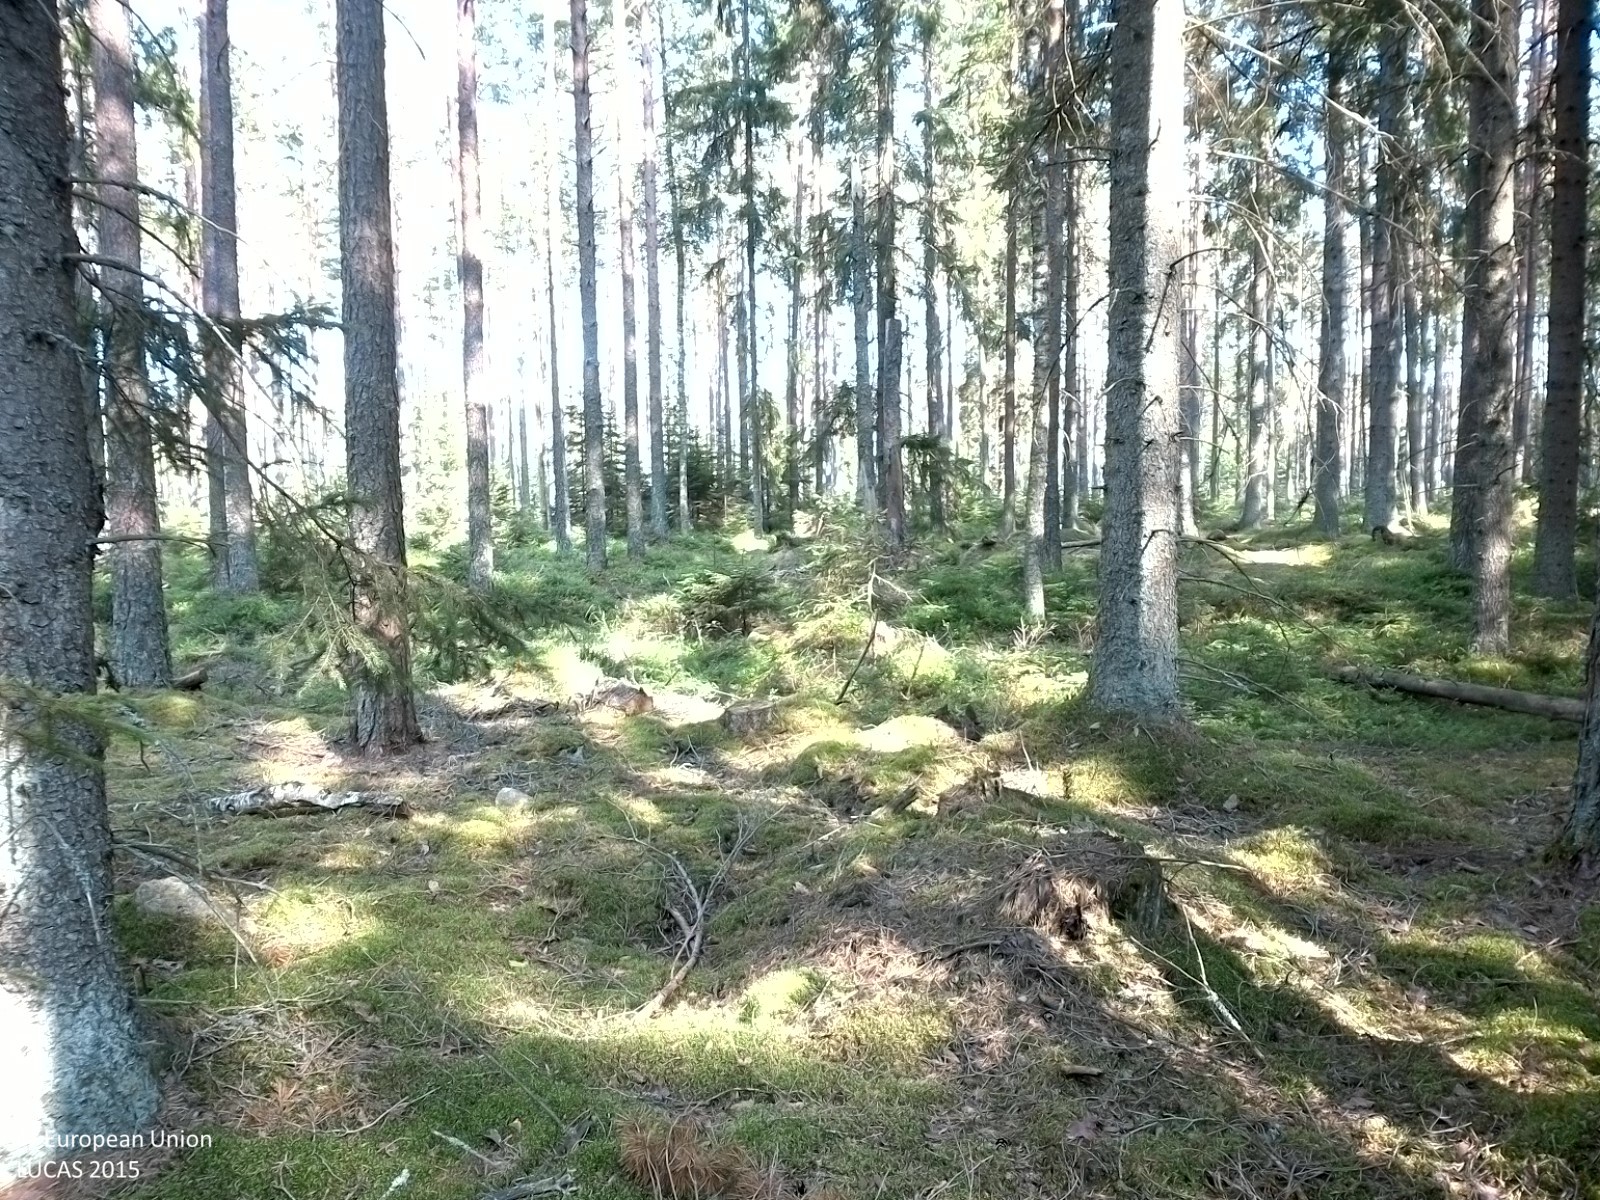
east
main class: Woodland
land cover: Pine dominated coniferous woodland
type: boreal forest
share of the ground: 25 - 50 %
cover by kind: lichens and mosses 40 %, coniferous forest trees 35 %, herbaceous plants 25 %
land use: Forestry
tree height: > 5 m
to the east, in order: Pine dominated coniferous woodland; Tracks; Pine dominated coniferous woodland; Other mixed woodland; Ditches and canals; Other mixed woodland
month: August
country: SE
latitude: 59.0189
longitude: 14.7470
